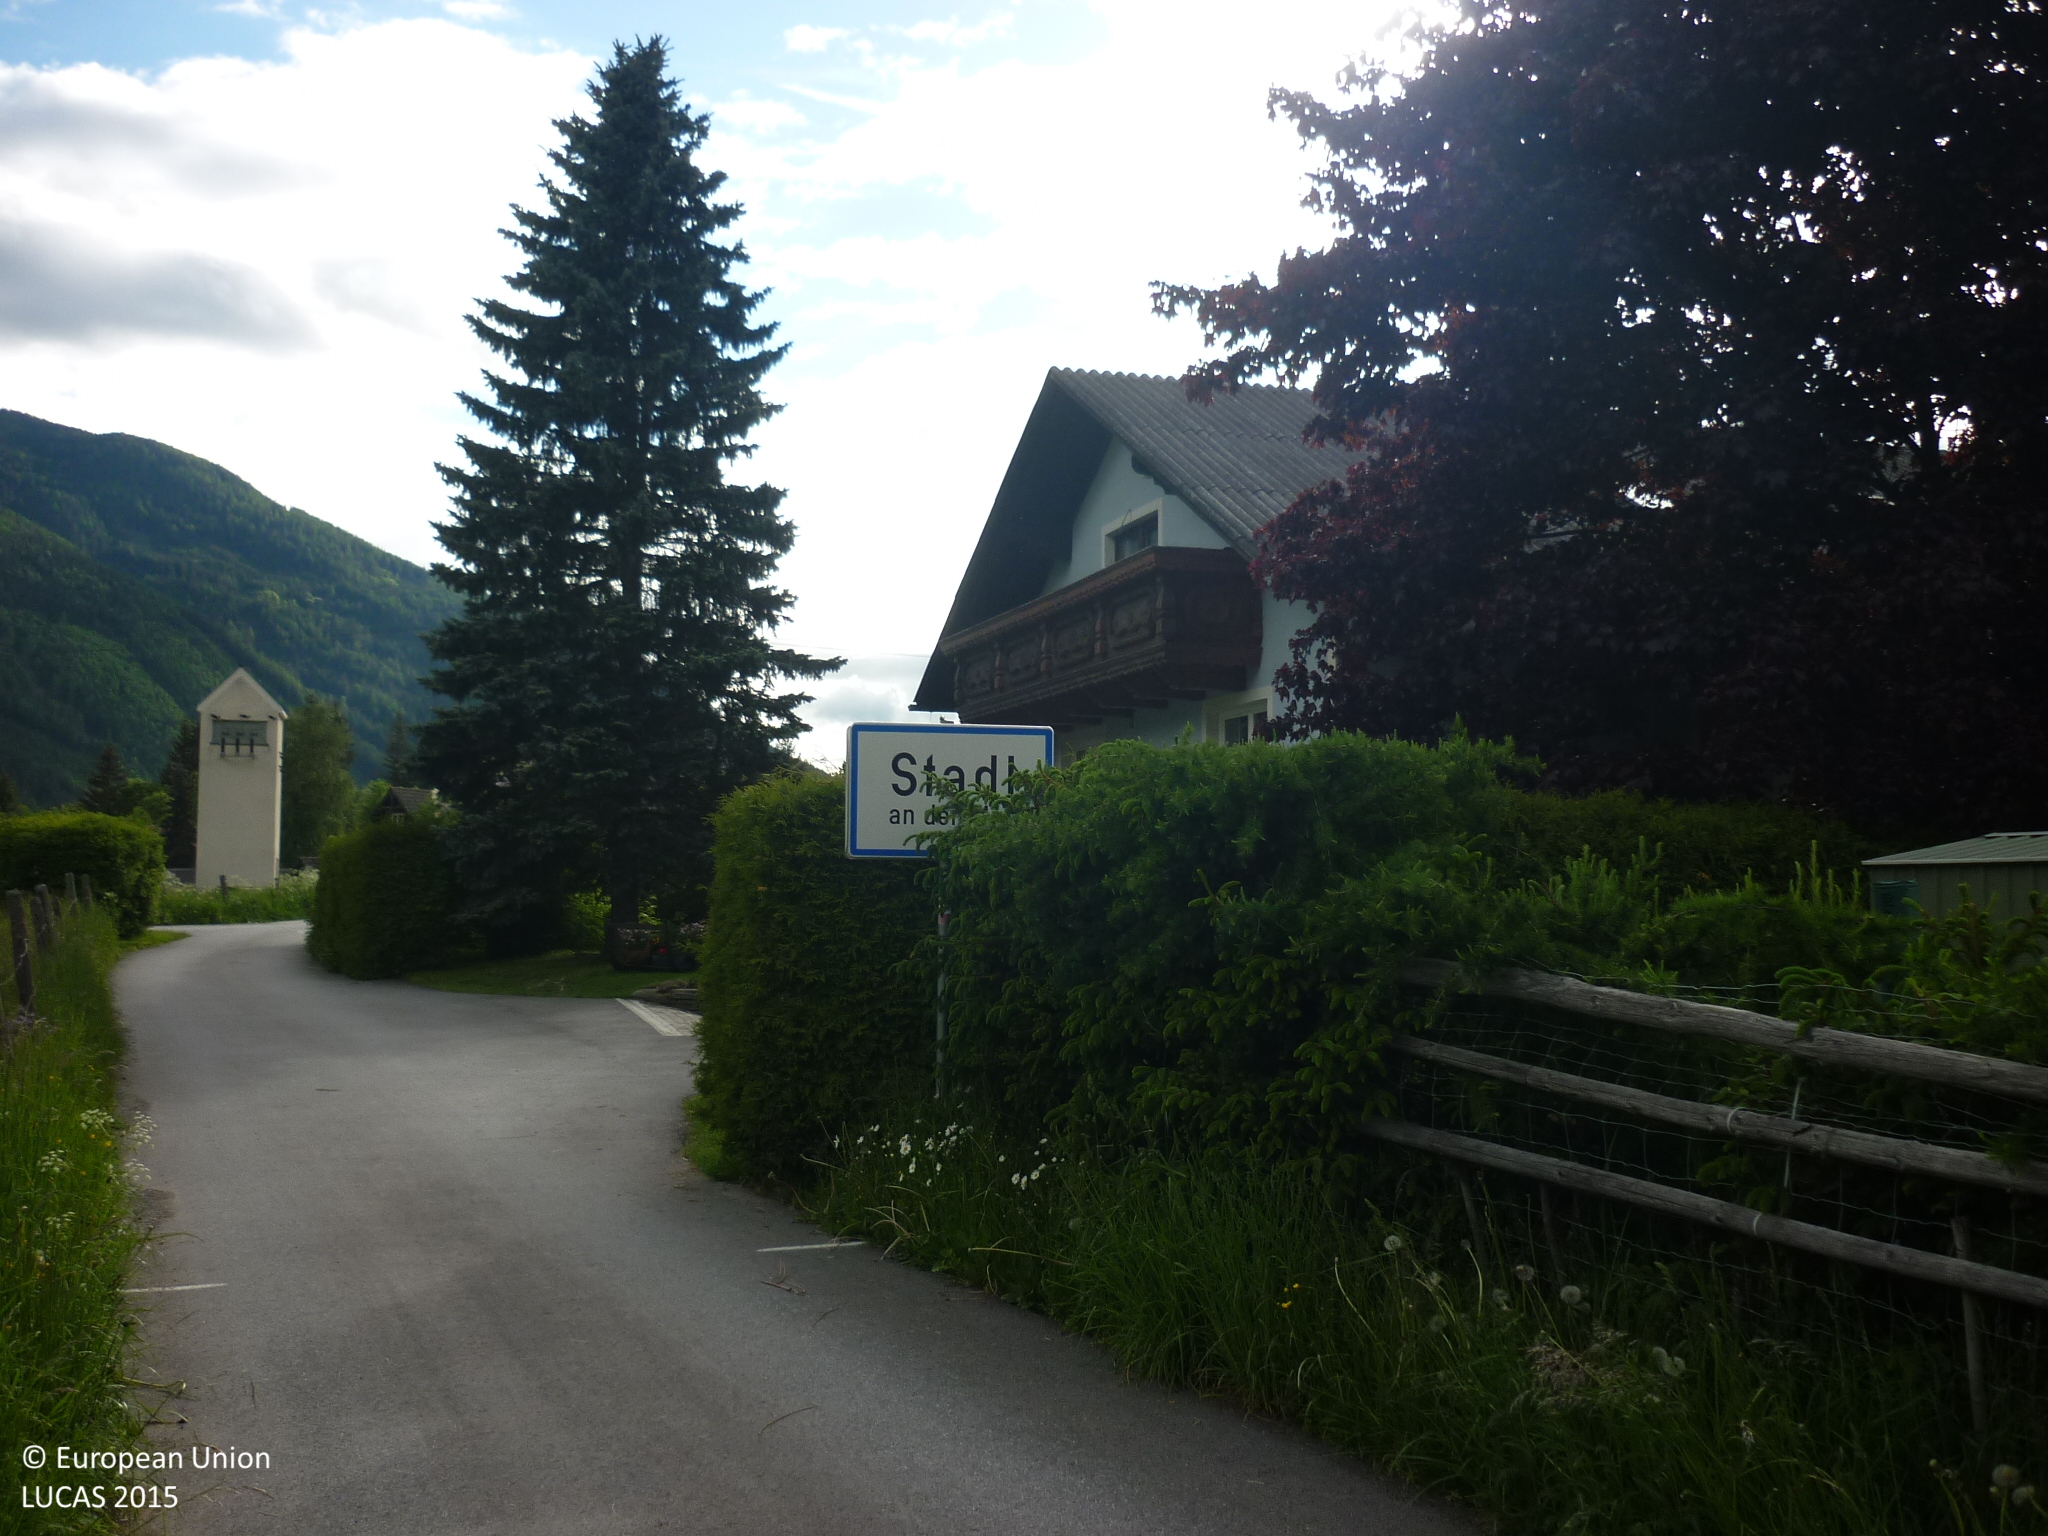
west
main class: Grassland
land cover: Grassland without tree/shrub cover
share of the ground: > 75 %
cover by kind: herbaceous plants 100 %
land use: Agriculture (excluding fallow land and kitchen gardens)
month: May
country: AT
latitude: 47.0881
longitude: 13.9894
